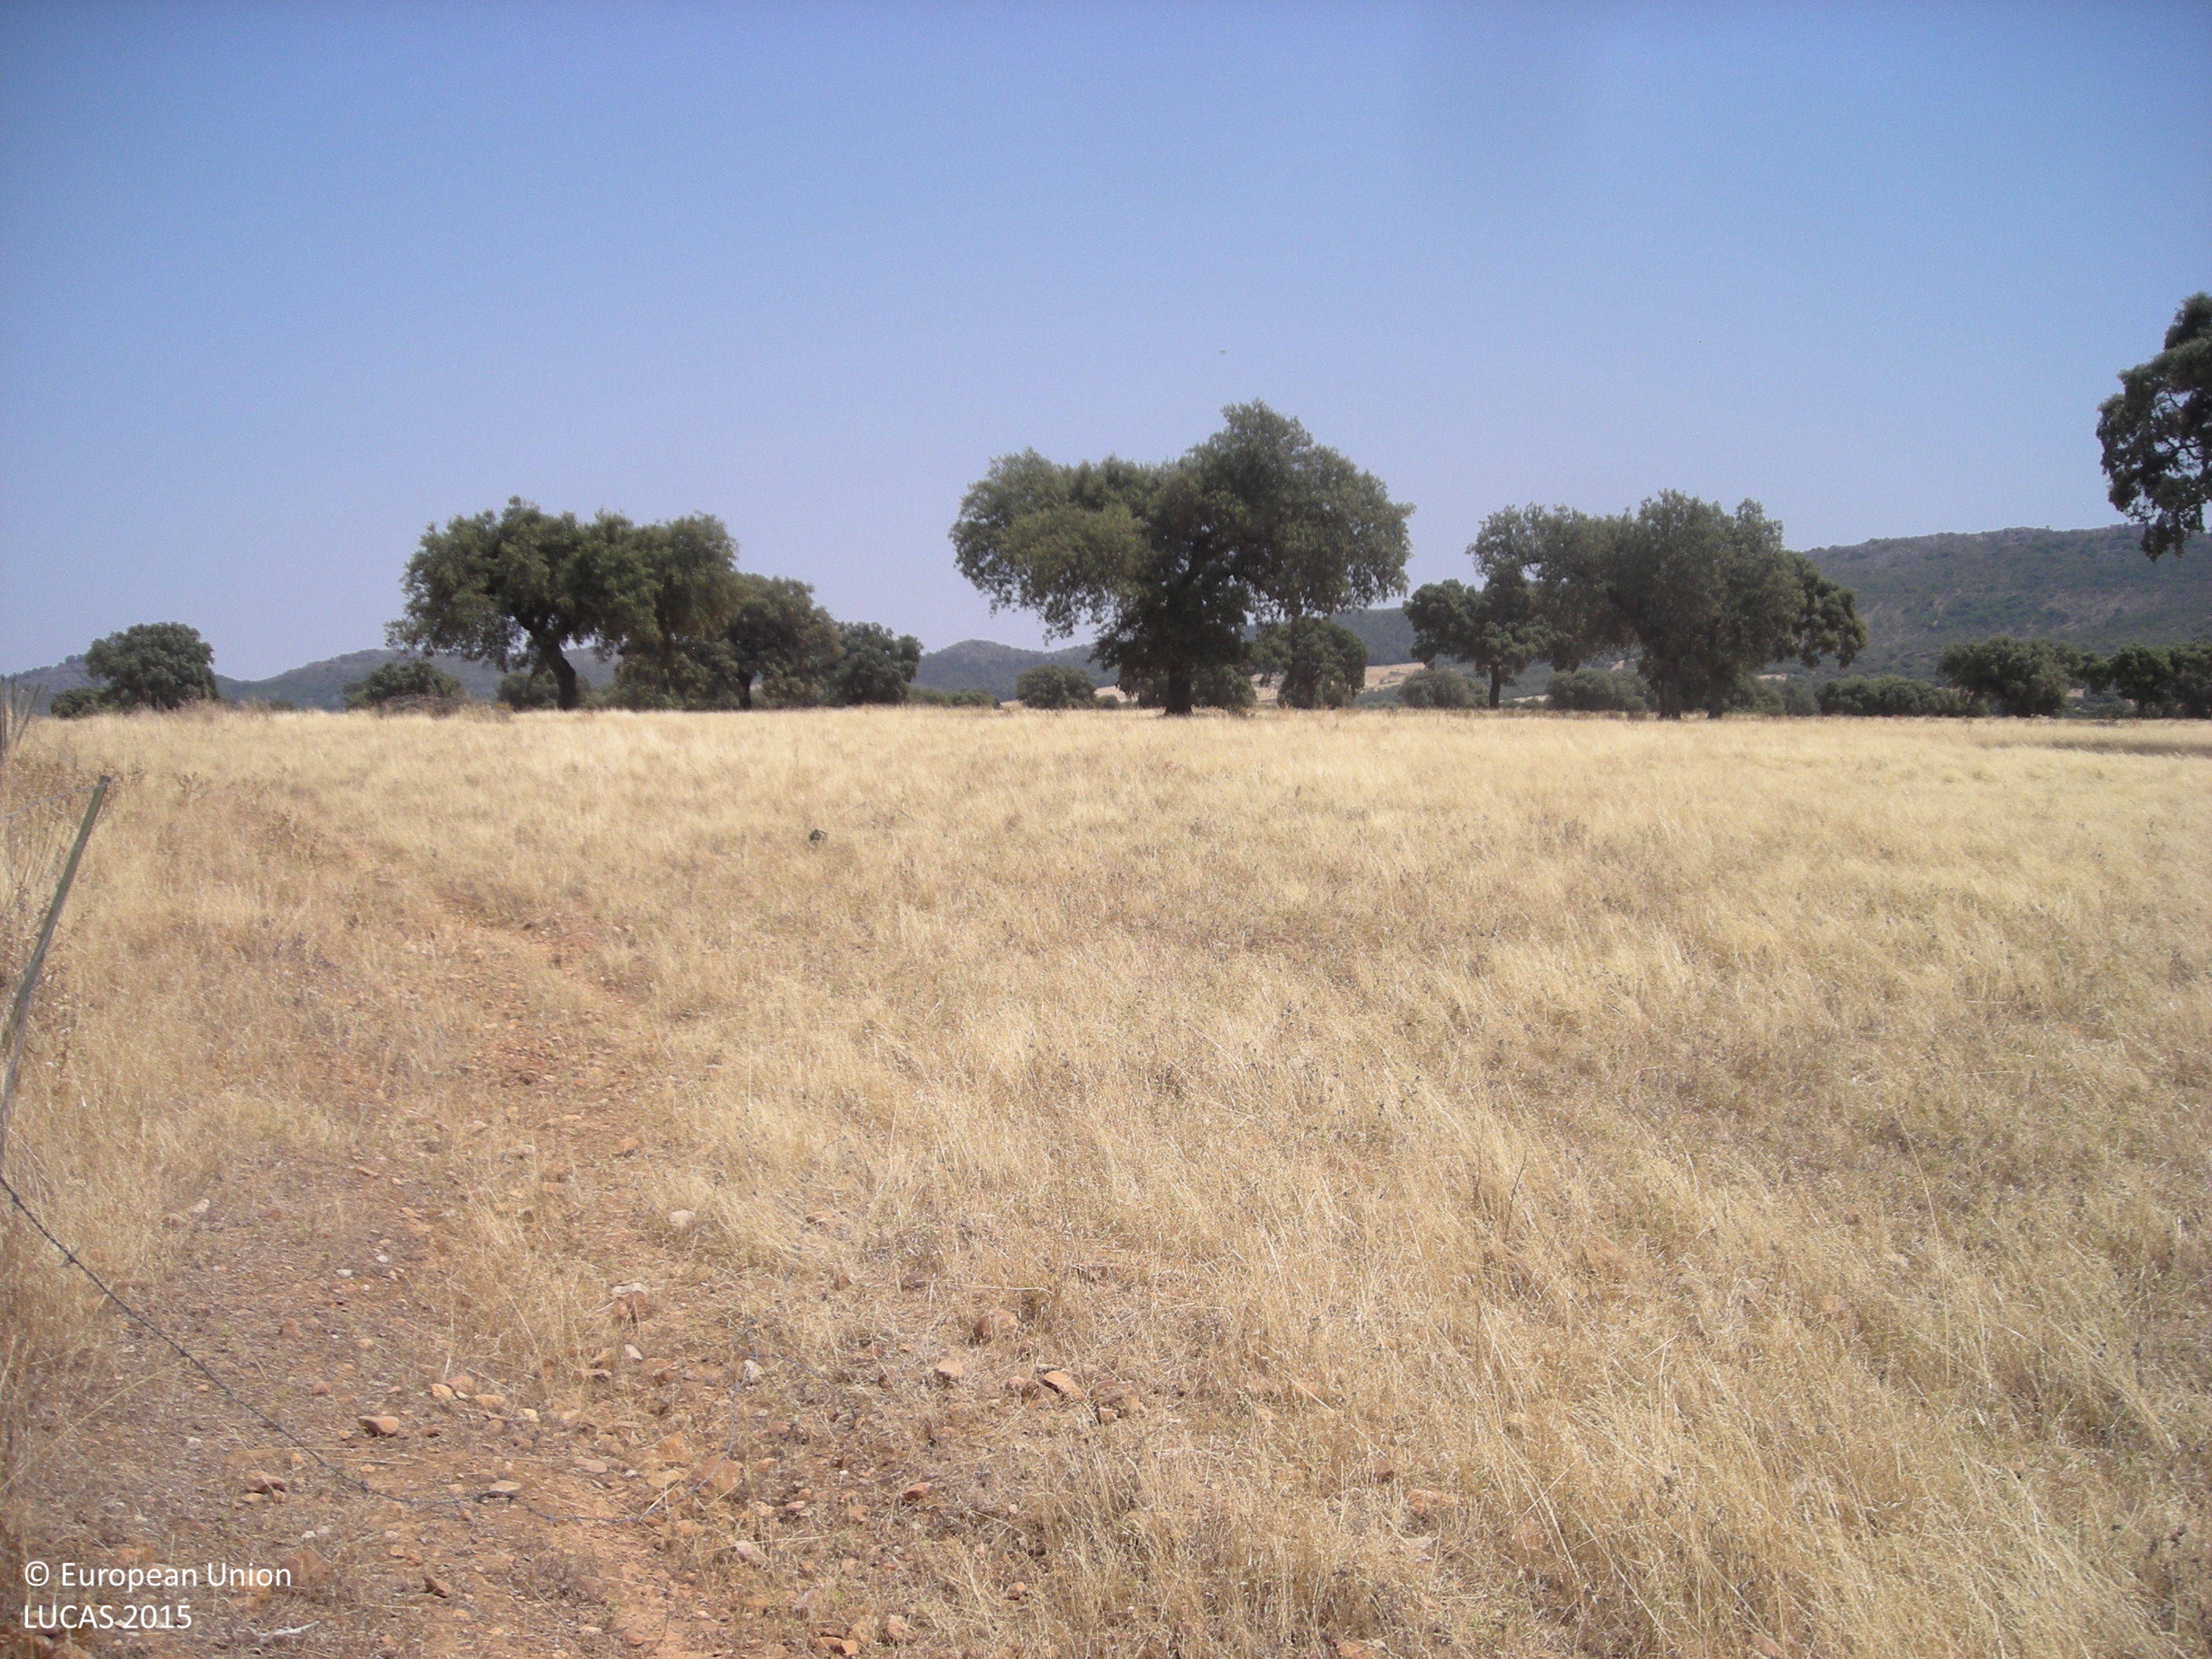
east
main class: Grassland
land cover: Grassland without tree/shrub cover
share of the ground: > 75 %
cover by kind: herbaceous plants 100 %
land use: Agriculture (excluding fallow land and kitchen gardens)
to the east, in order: Grassland without tree/shrub cover
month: July
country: ES
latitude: 39.2071
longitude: -5.2953
